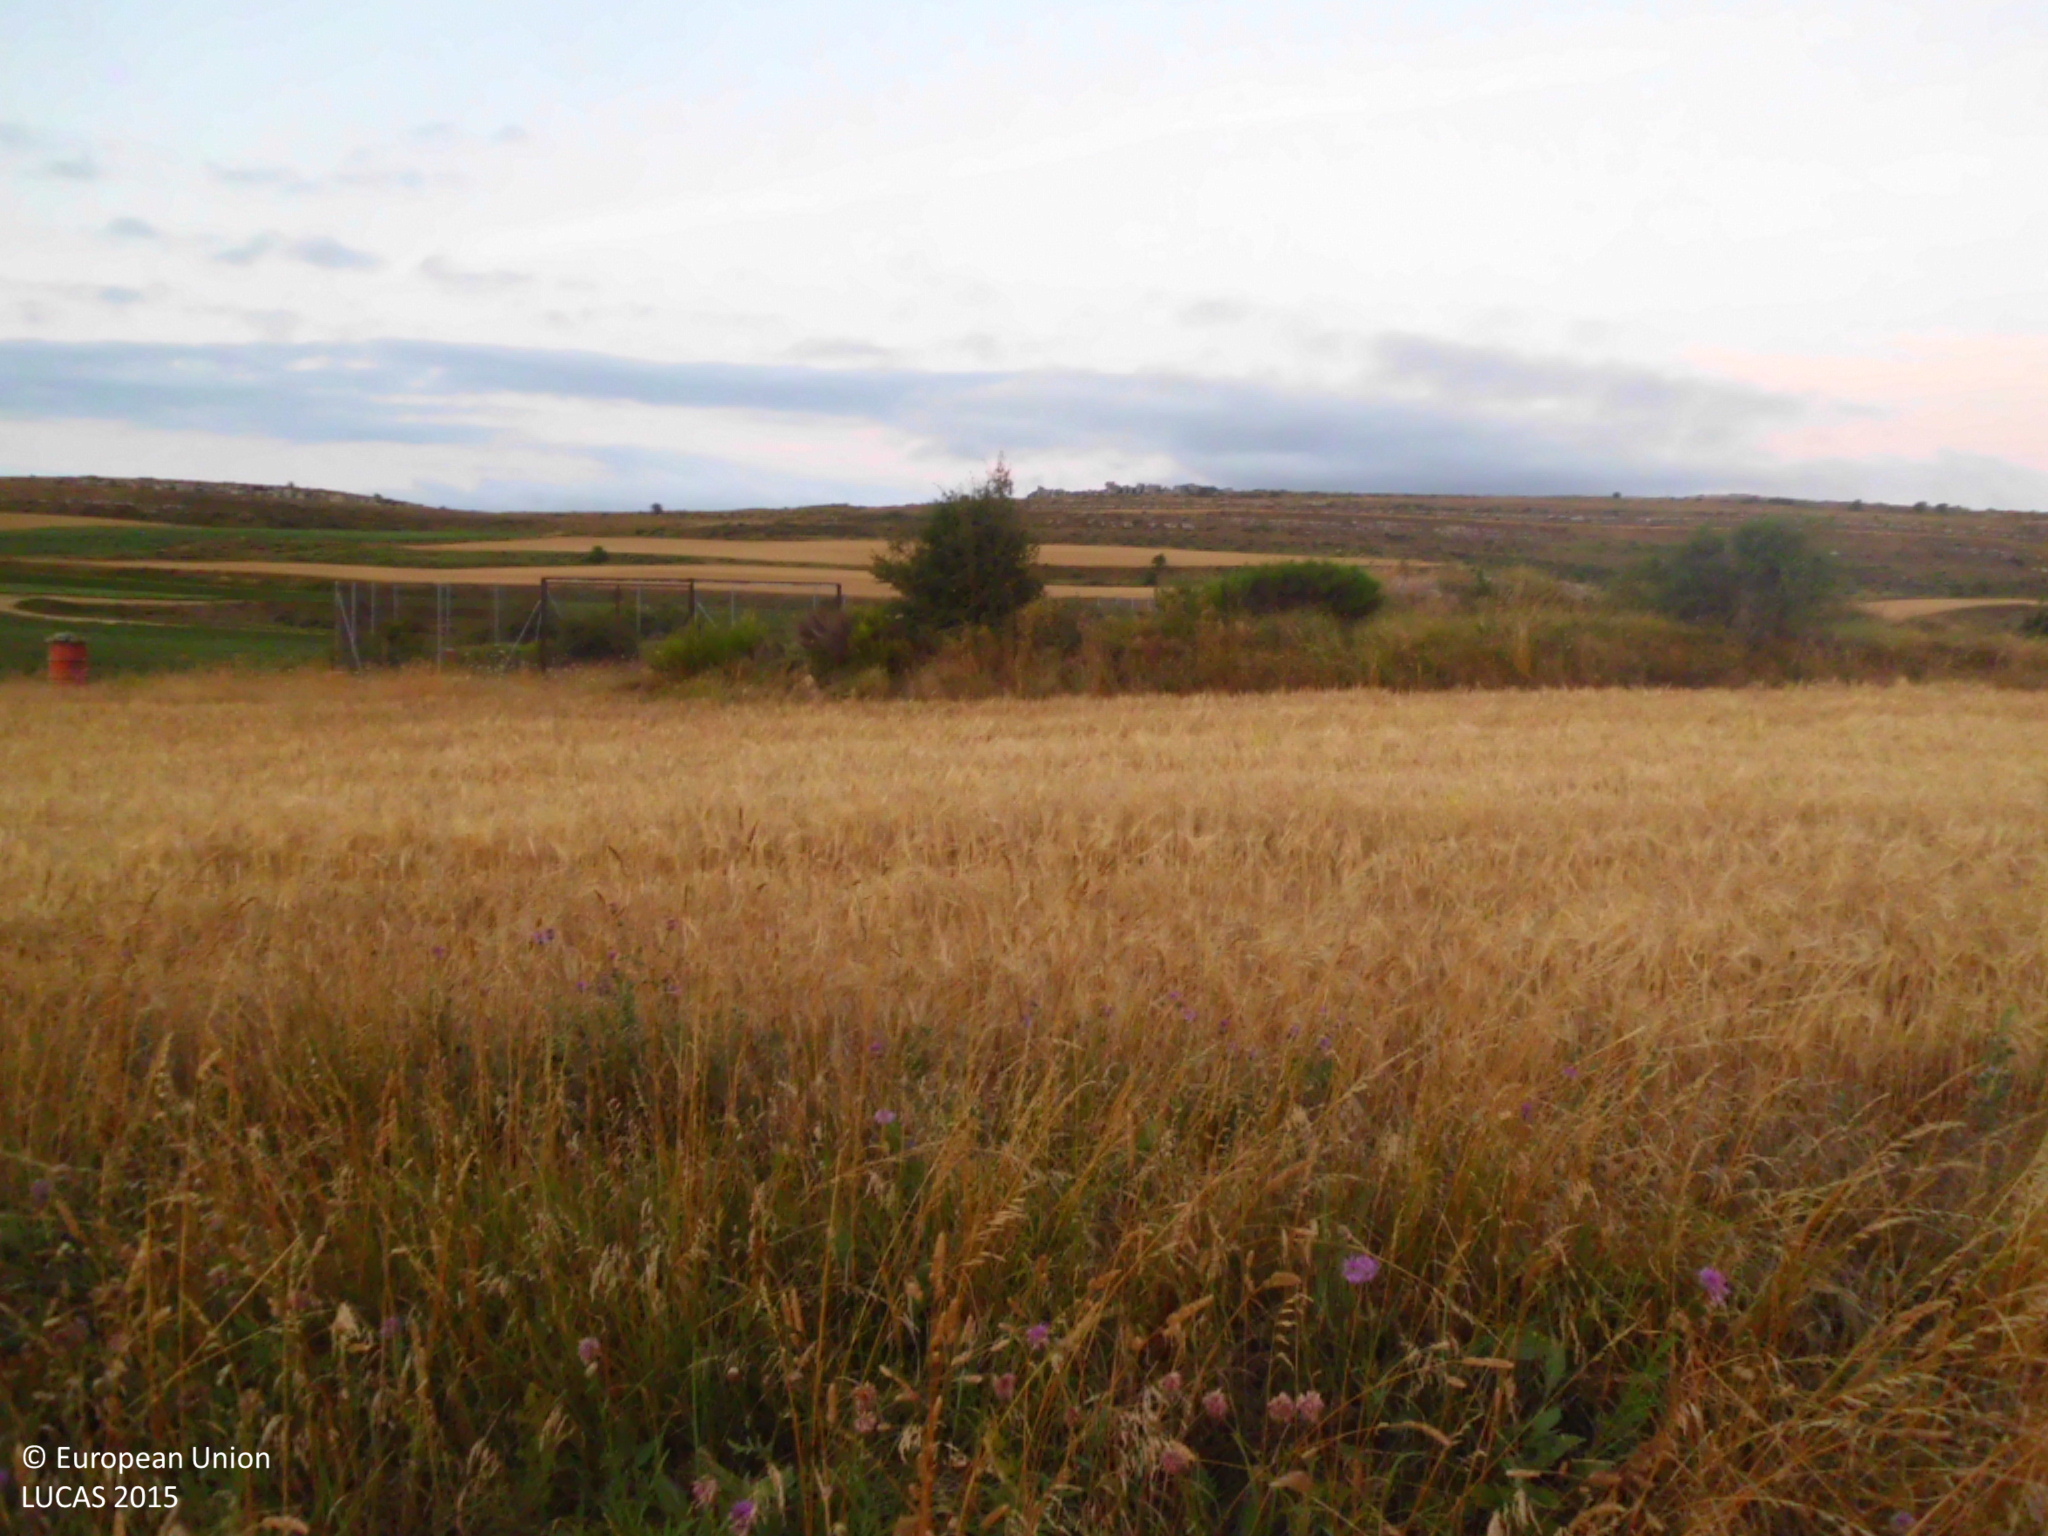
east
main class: Cropland
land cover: Barley
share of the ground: > 75 %
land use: Agriculture (excluding fallow land and kitchen gardens)
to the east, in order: Grass margins; Barley; Shrubland without tree cover; Barley; Grass margins; Tracks; Potatoes; Shrubland without tree cover; Other bare soil
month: July
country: ES
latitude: 42.7526
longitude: -4.2838
